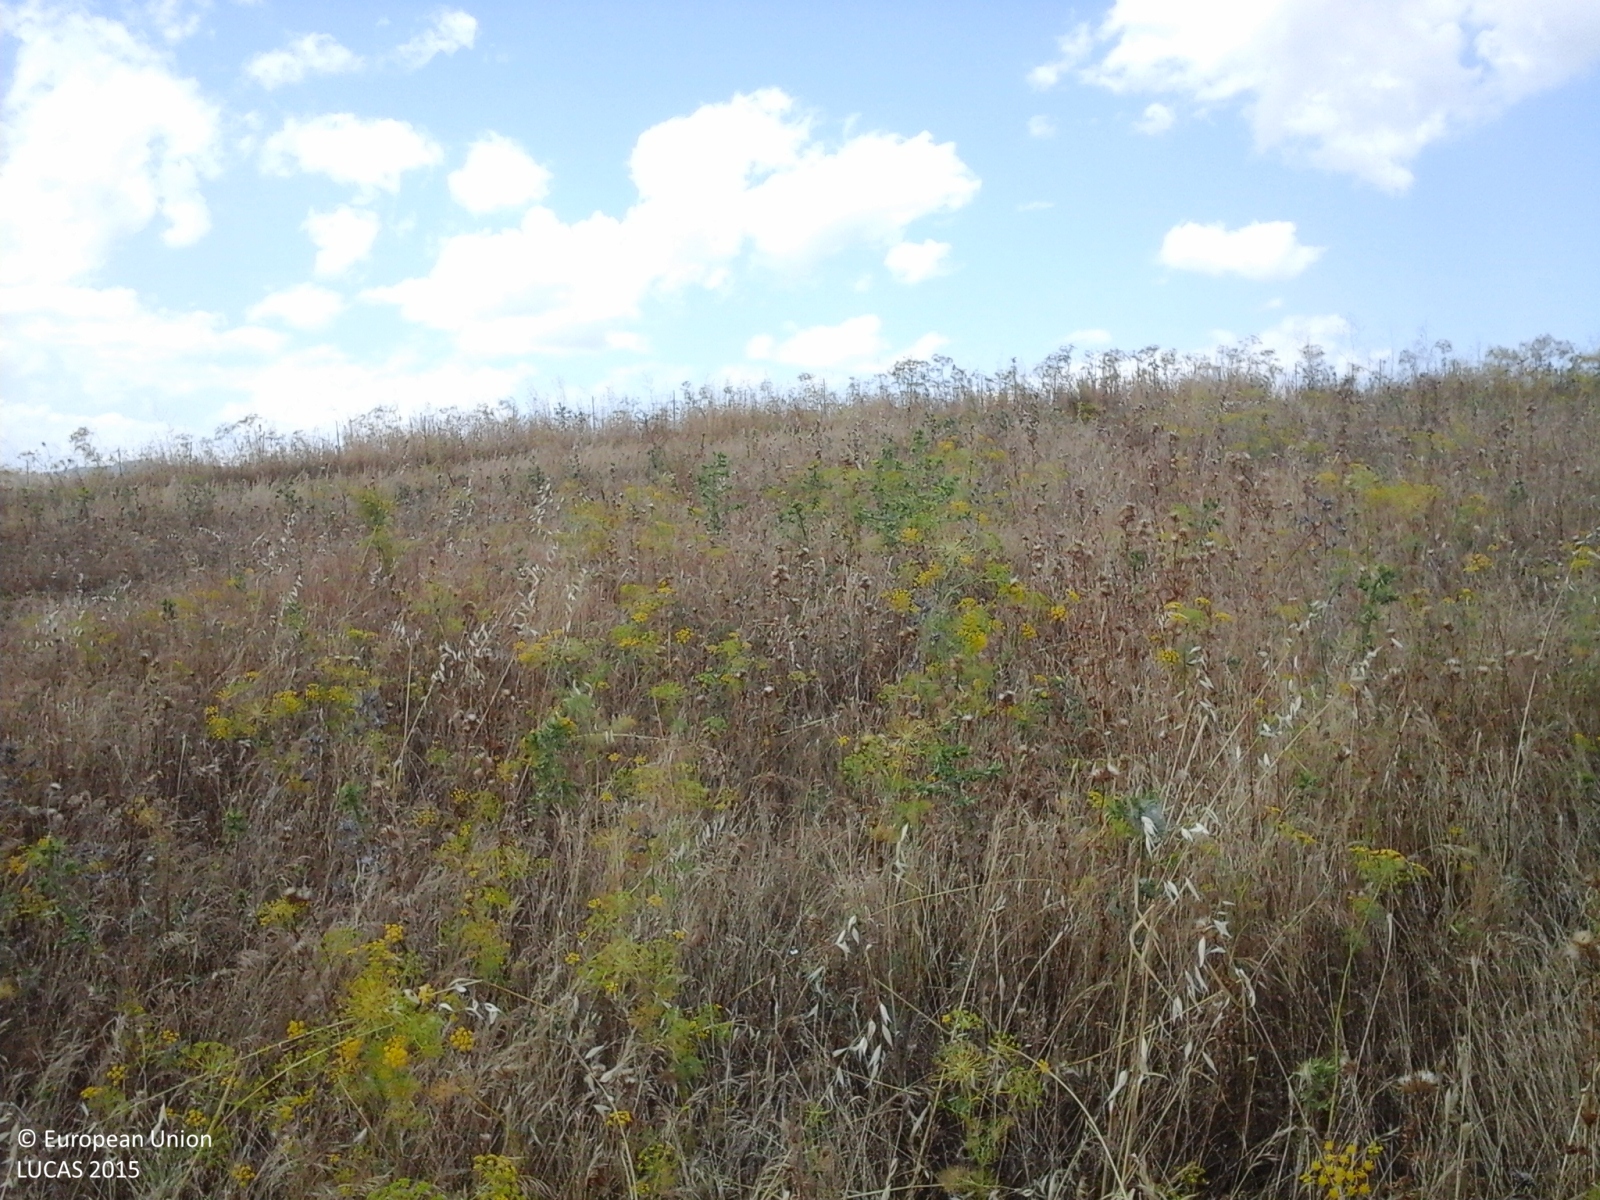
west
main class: Grassland
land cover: Grassland without tree/shrub cover
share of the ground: > 75 %
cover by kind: herbaceous plants 75 %, unconsolidated bare surface 25 %
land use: Agriculture (excluding fallow land and kitchen gardens)
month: June
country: IT
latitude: 37.5540
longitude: 14.4163
